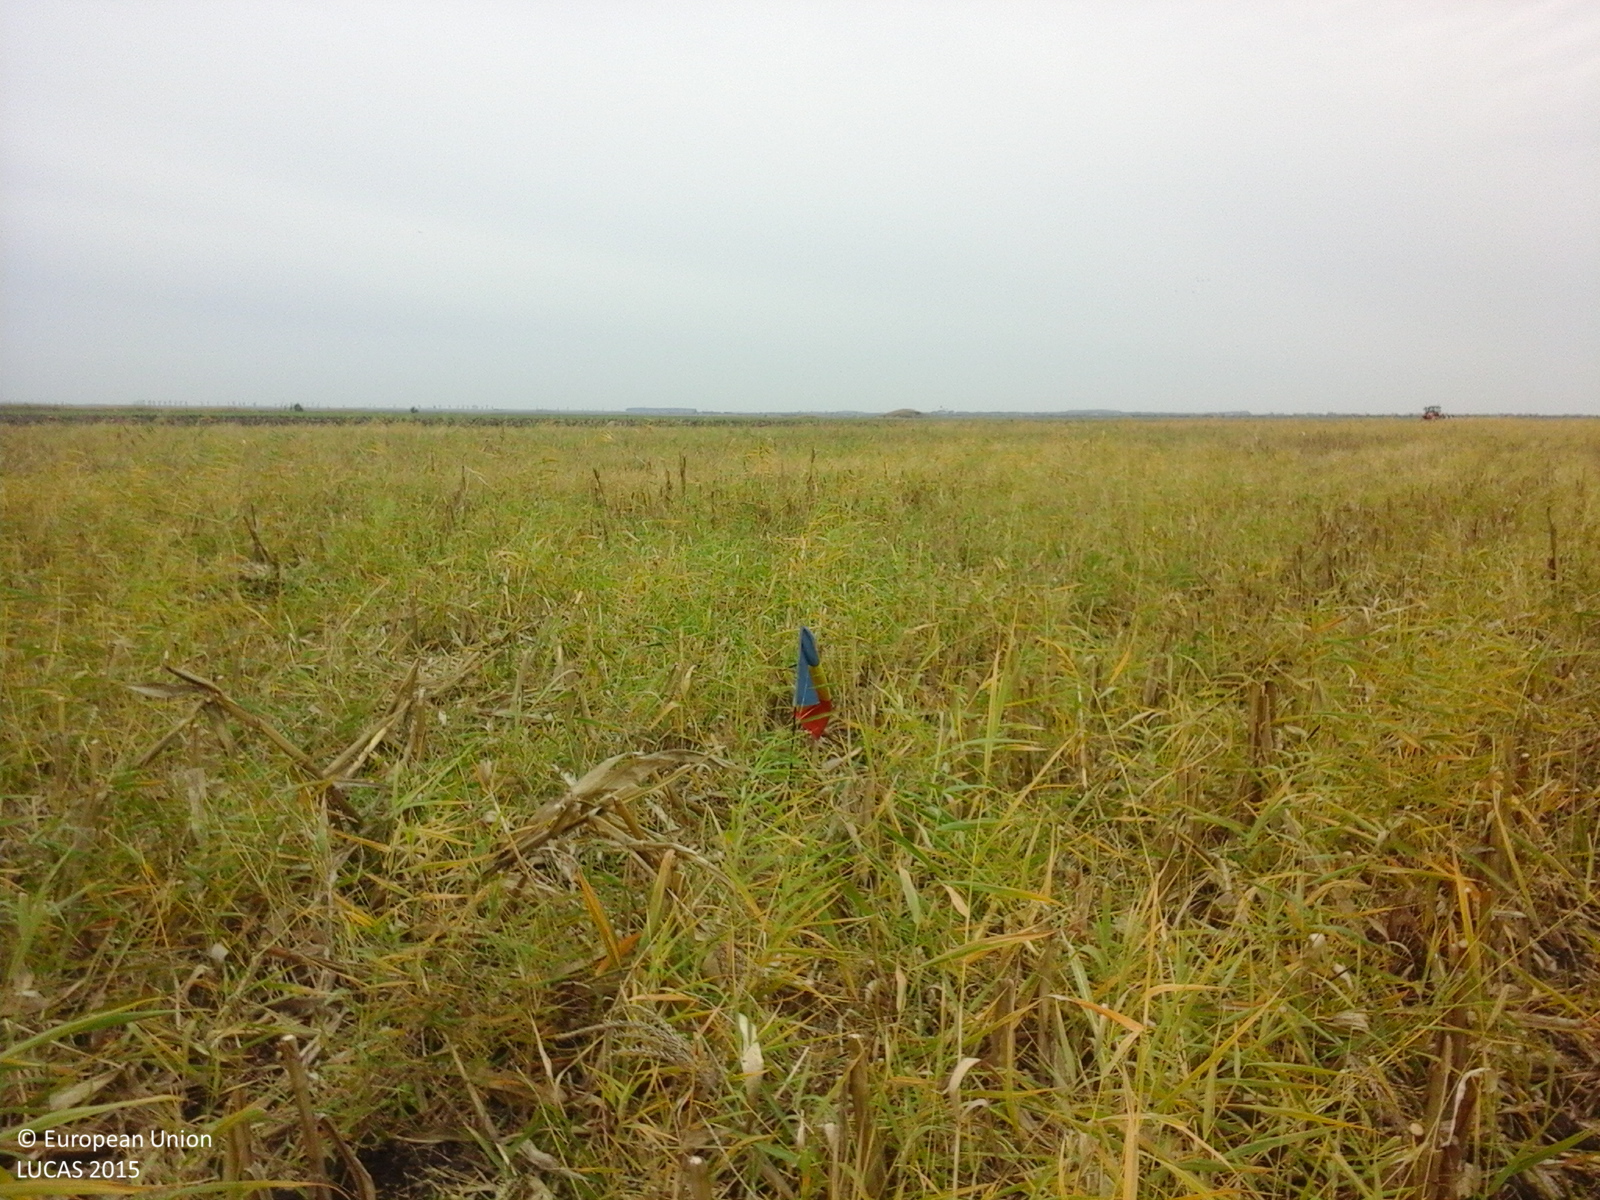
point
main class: Cropland
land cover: Maize
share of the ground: 50 - 75 %
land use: Agriculture (excluding fallow land and kitchen gardens)
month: October
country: RO
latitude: 44.9277
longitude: 26.3983
